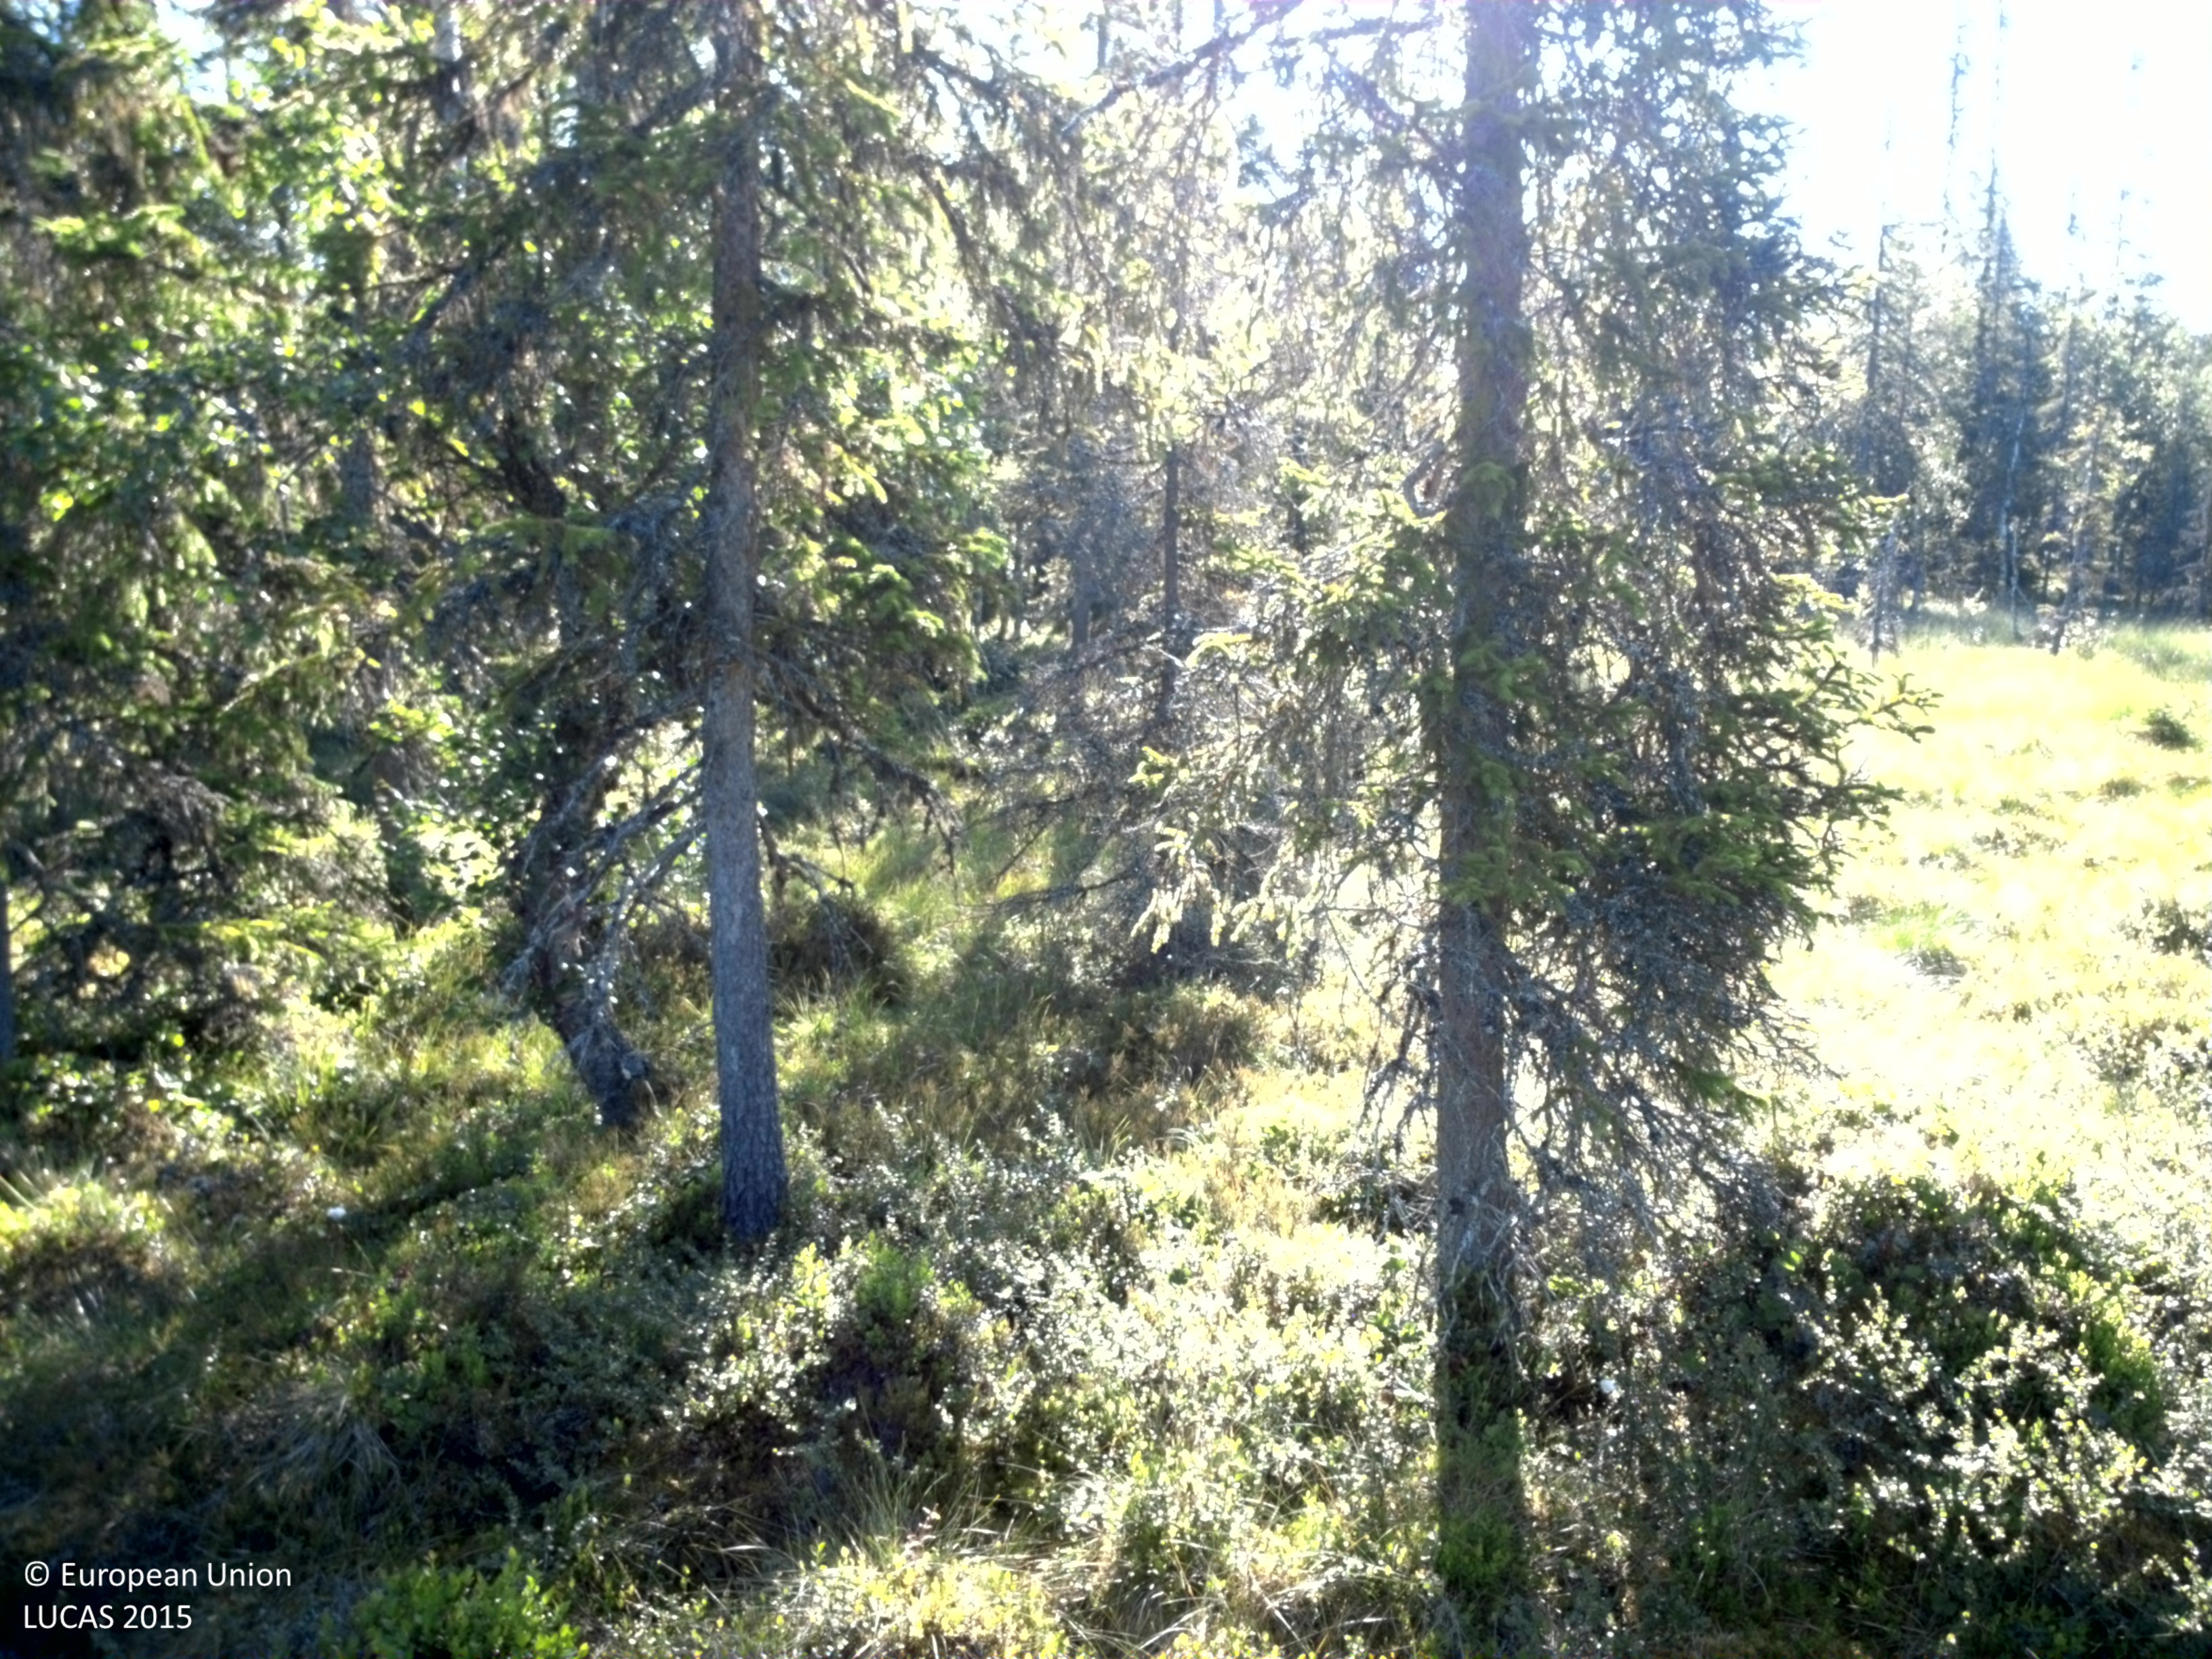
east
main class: Woodland
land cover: Other coniferous woodland
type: boreal forest
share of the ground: 10 - 25 %
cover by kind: shrubs 40 %, lichens and mosses 35 %, coniferous forest trees 25 %
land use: Semi-natural and natural areas not in use
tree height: > 5 m
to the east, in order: Other coniferous woodland; Spruce dominated mixed woodland; Rivers and streams; Spruce dominated mixed woodland; Spruce dominated coniferous woodland
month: August
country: SE
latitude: 61.5386
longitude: 13.6923
